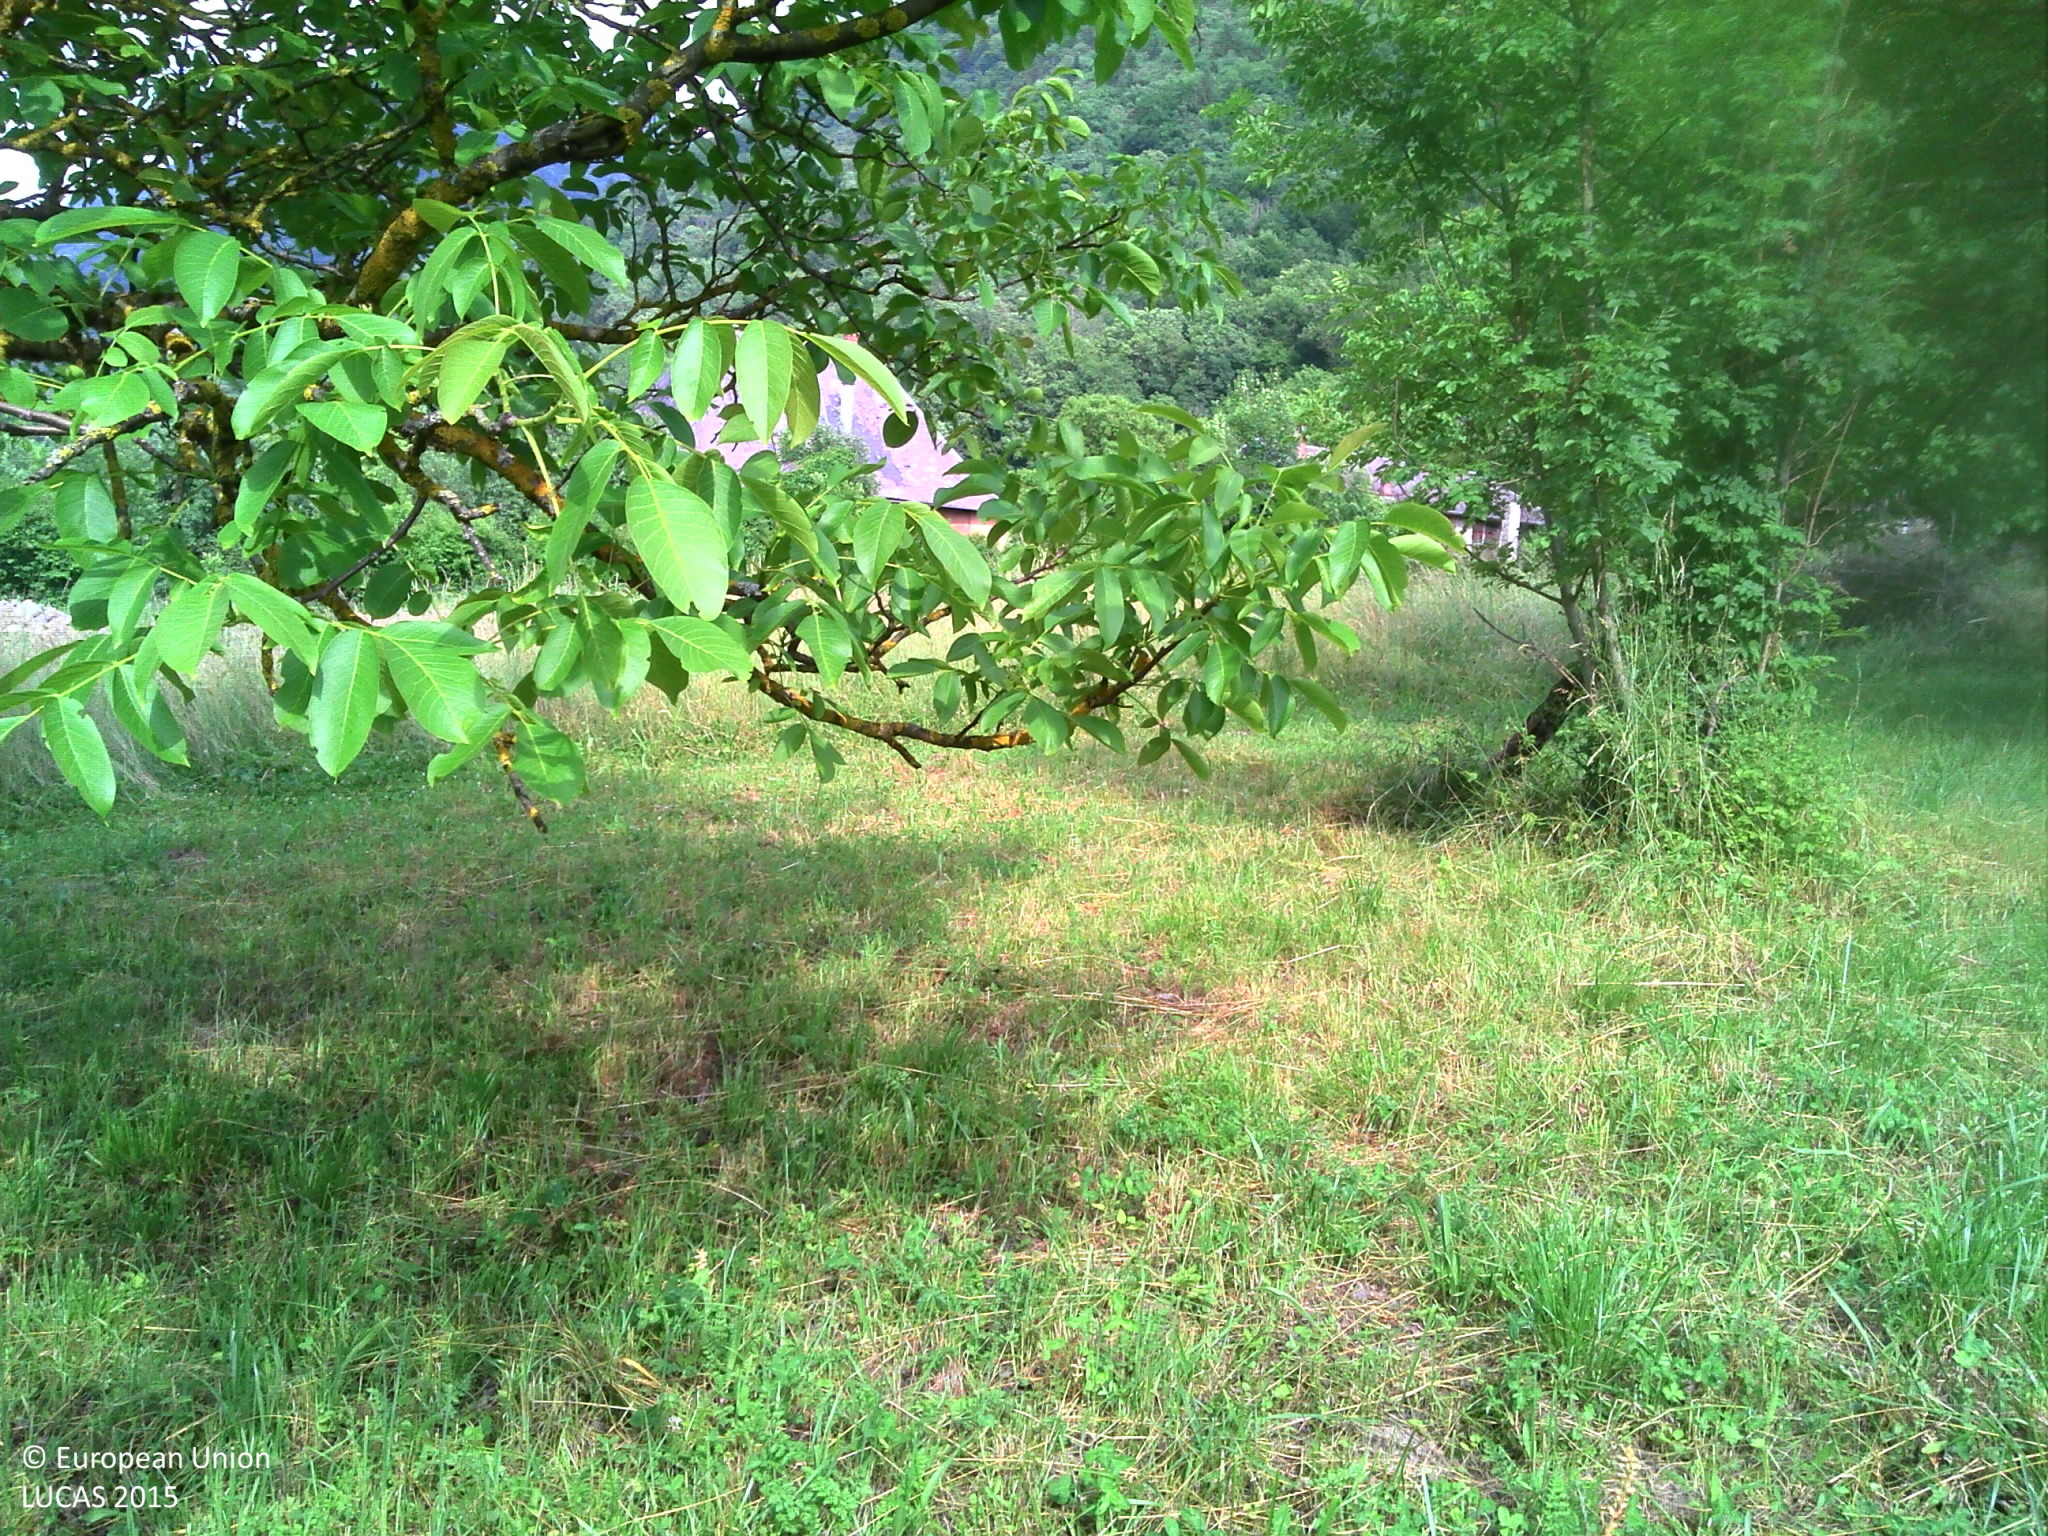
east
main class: Cropland
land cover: Nuts trees
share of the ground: < 10 %
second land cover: Grassland without tree/shrub cover
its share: > 75 %
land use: Agriculture (excluding fallow land and kitchen gardens)
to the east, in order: Nuts trees; Grassland without tree/shrub cover; Spontaneously vegetated surfaces; Artificial constructions in urban areas; Grassland without tree/shrub cover
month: June
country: FR
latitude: 45.5263
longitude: 6.2020
